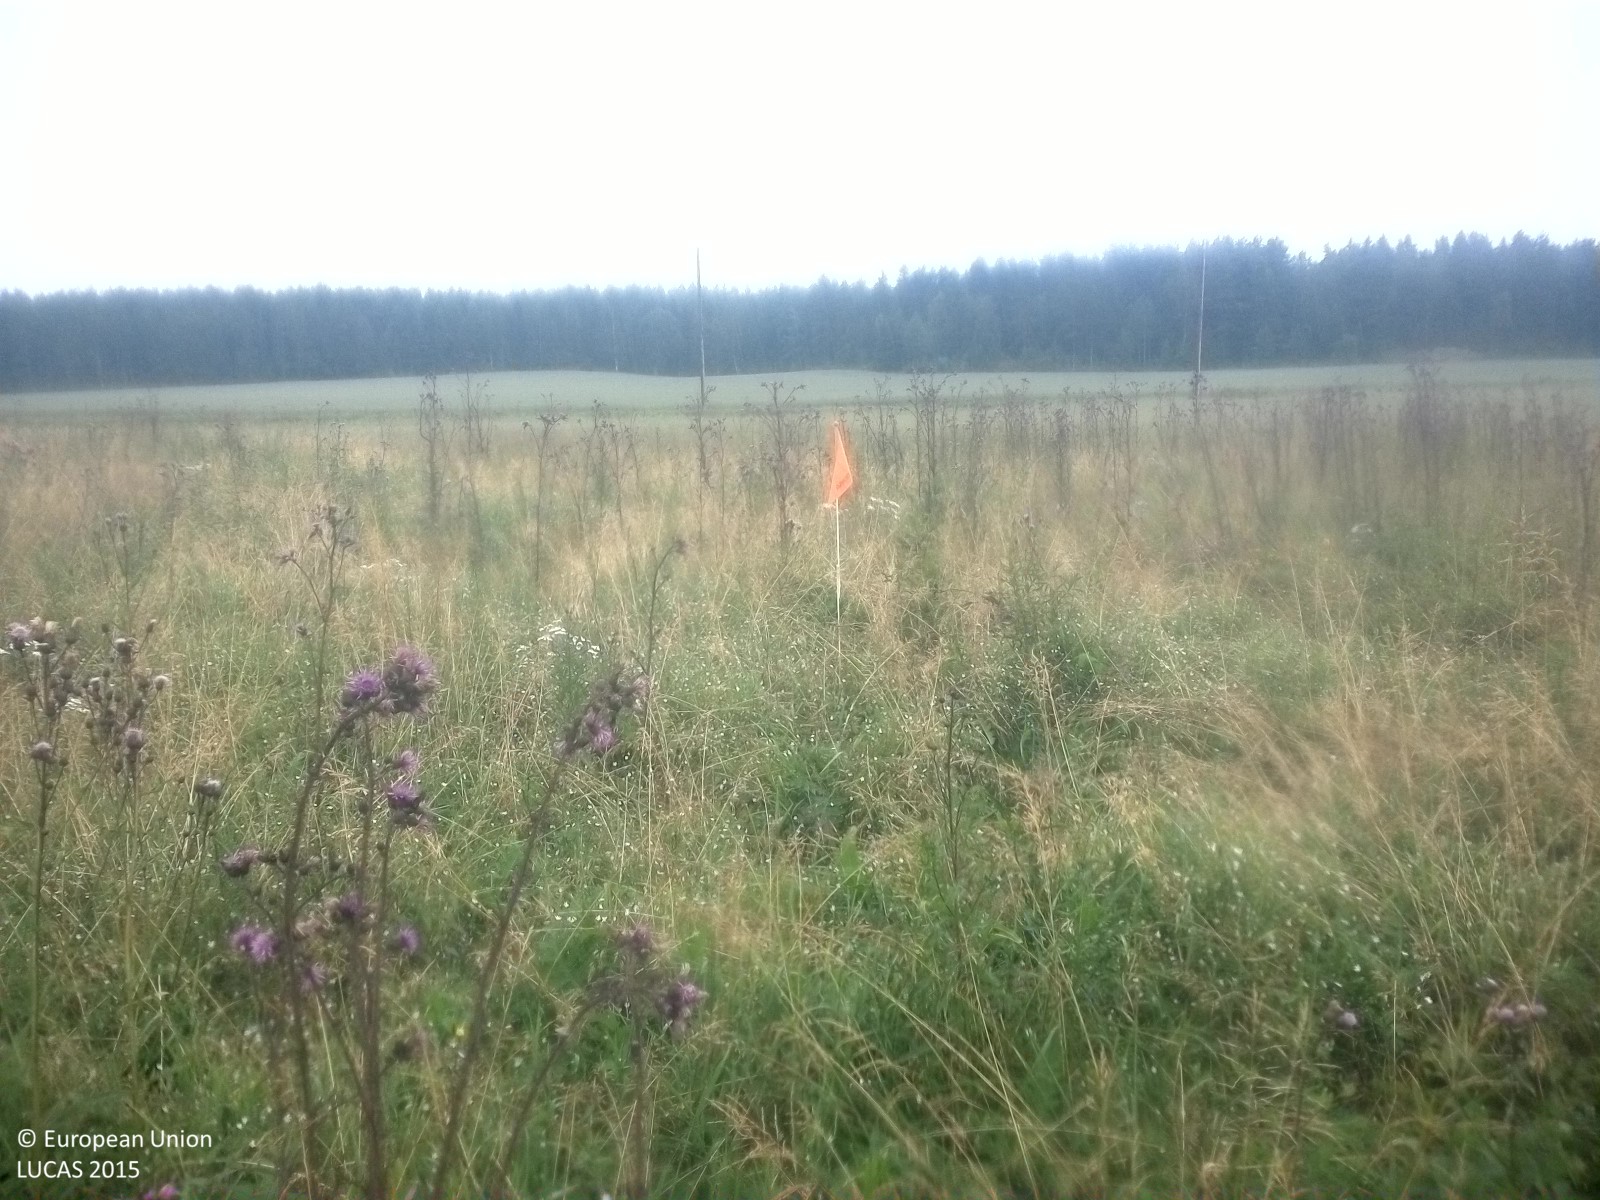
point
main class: Grassland
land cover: Spontaneously vegetated surfaces
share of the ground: > 75 %
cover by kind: herbaceous plants 100 %
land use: Agriculture (excluding fallow land and kitchen gardens)
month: July
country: SE
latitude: 58.9001
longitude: 15.0436
